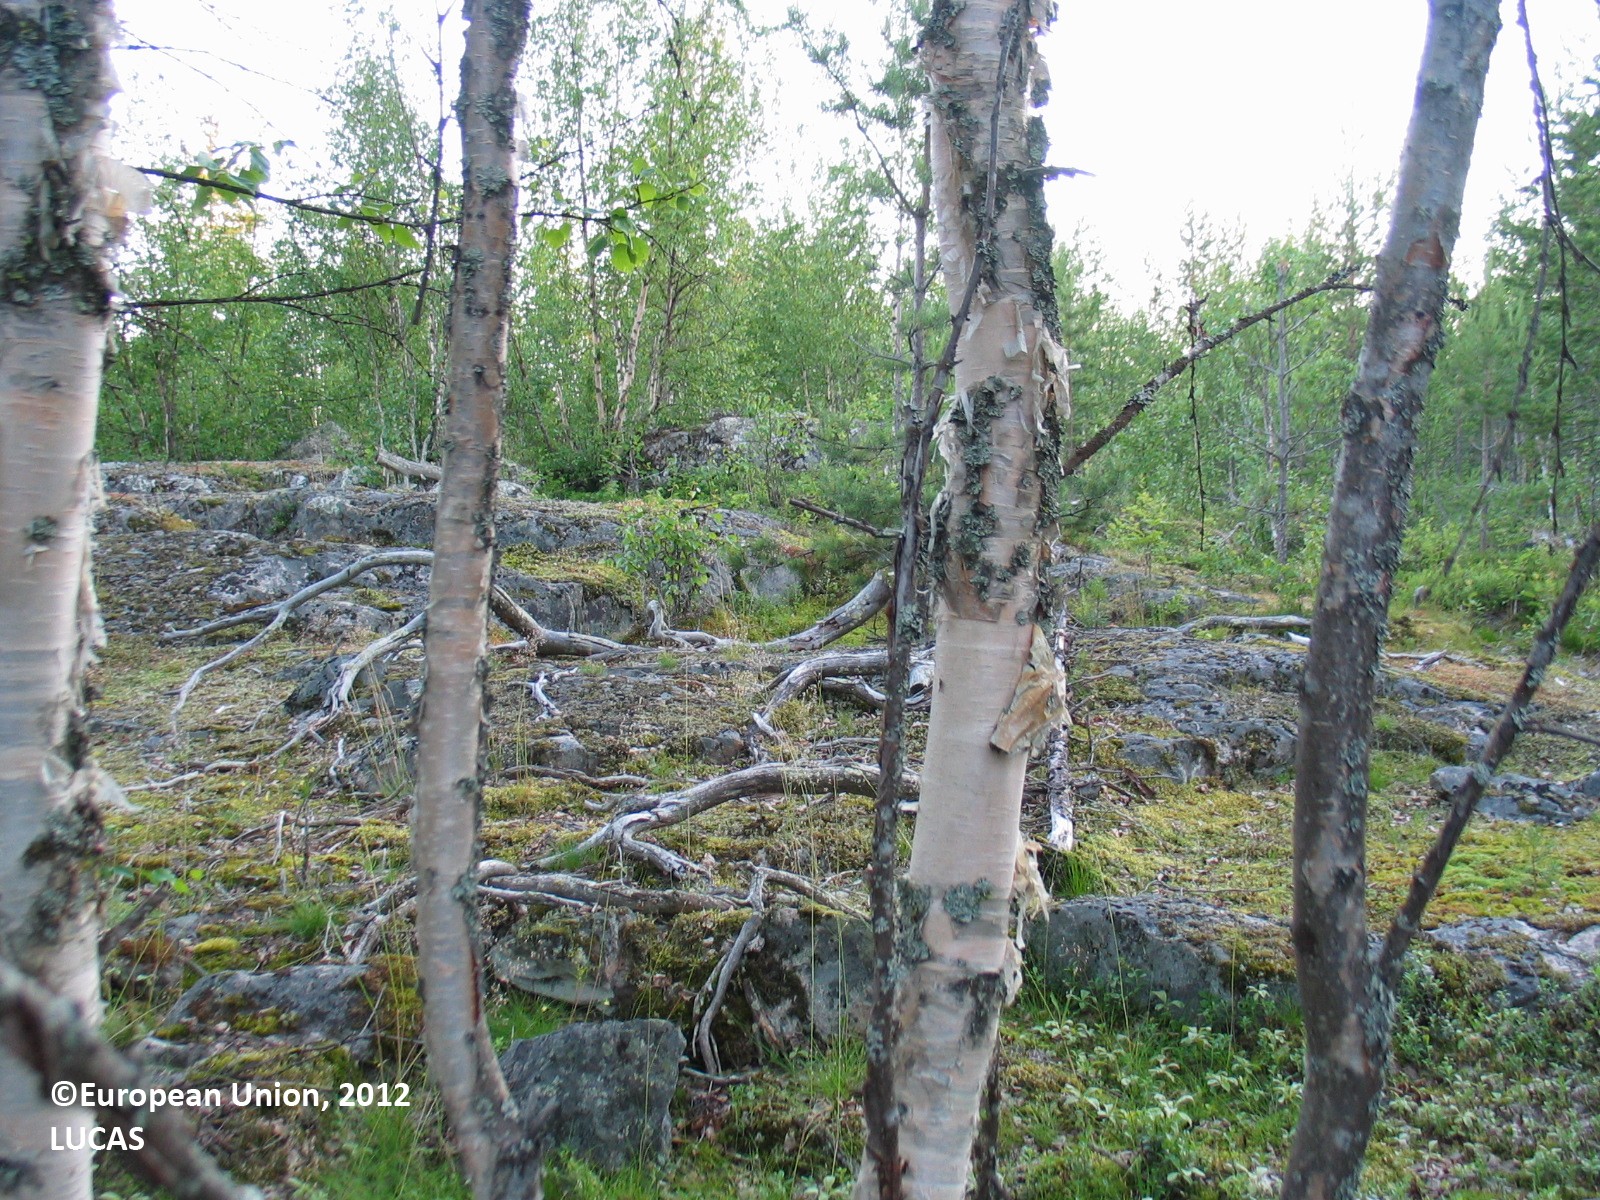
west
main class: Woodland
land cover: Other mixed woodland
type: boreal forest
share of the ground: 25 - 50 %
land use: Forestry
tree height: > 5 m
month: July
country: FI
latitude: 65.6736
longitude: 25.0111
